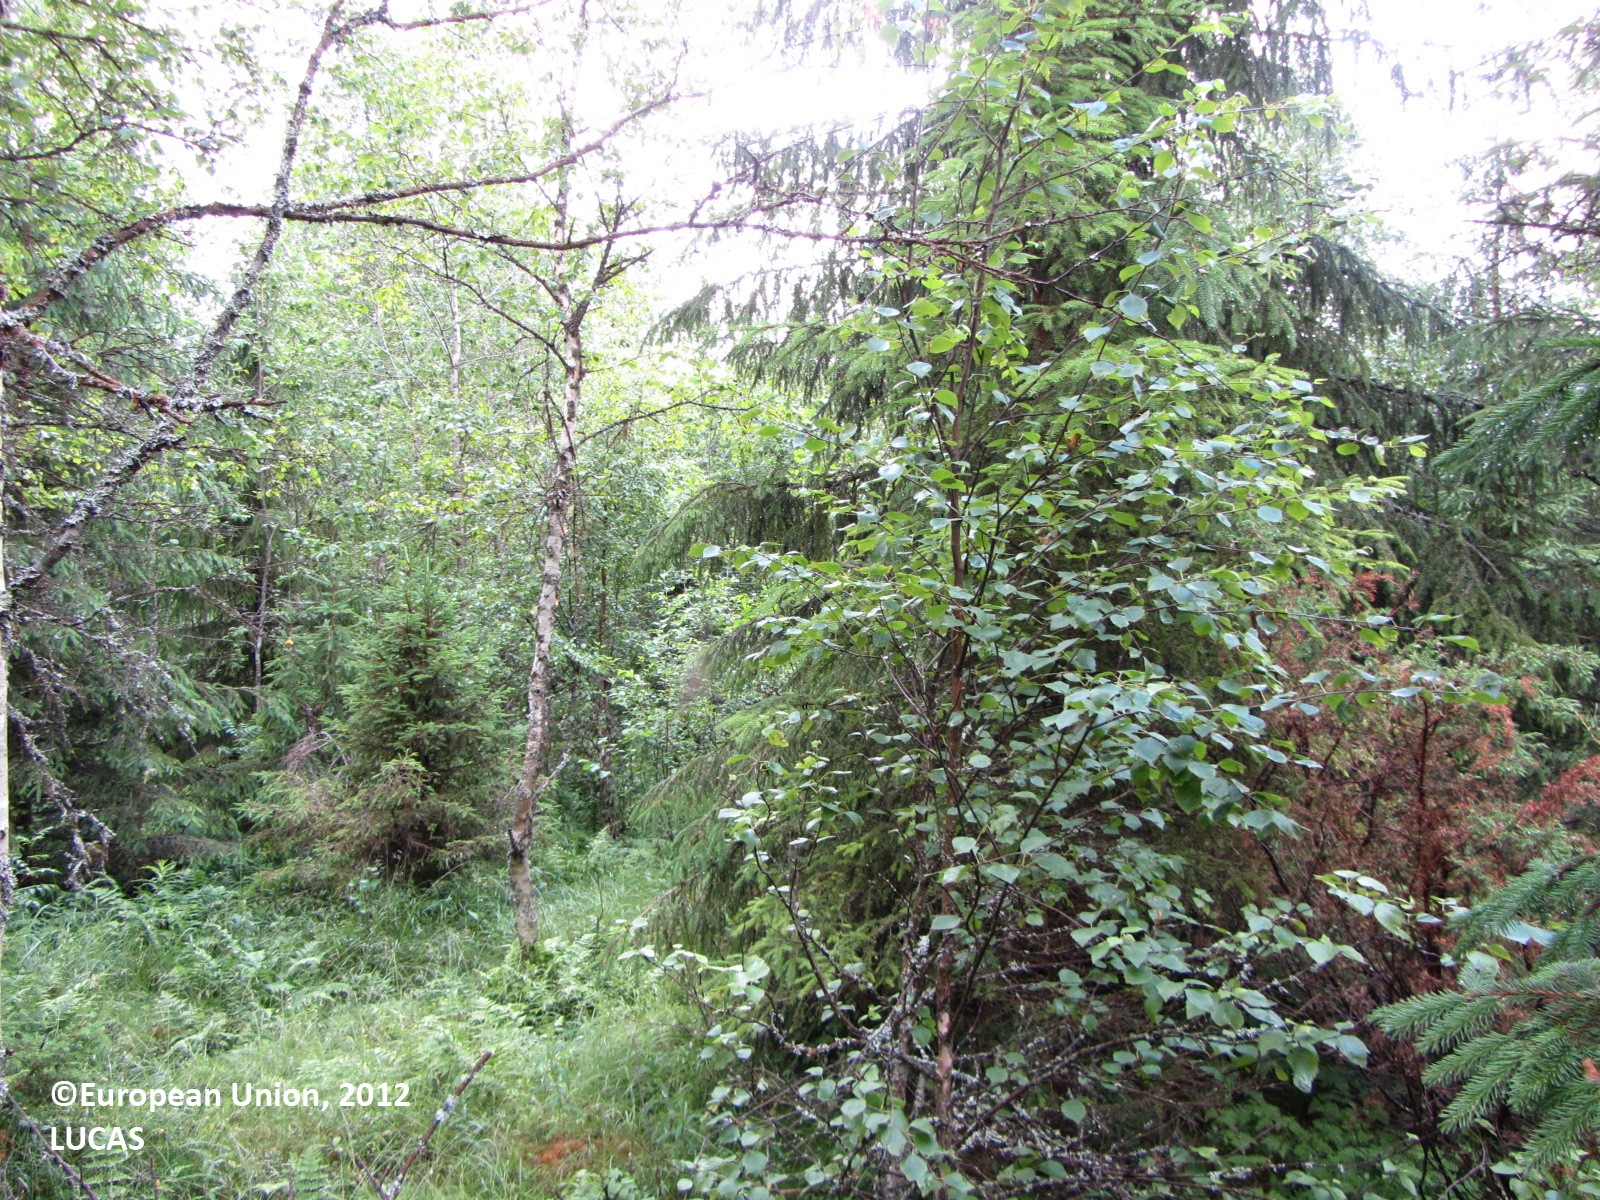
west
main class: Woodland
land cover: Spruce dominated mixed woodland
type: boreal forest
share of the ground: 50 - 75 %
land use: Forestry
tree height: > 5 m
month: July
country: FI
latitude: 63.8442
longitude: 25.5725
